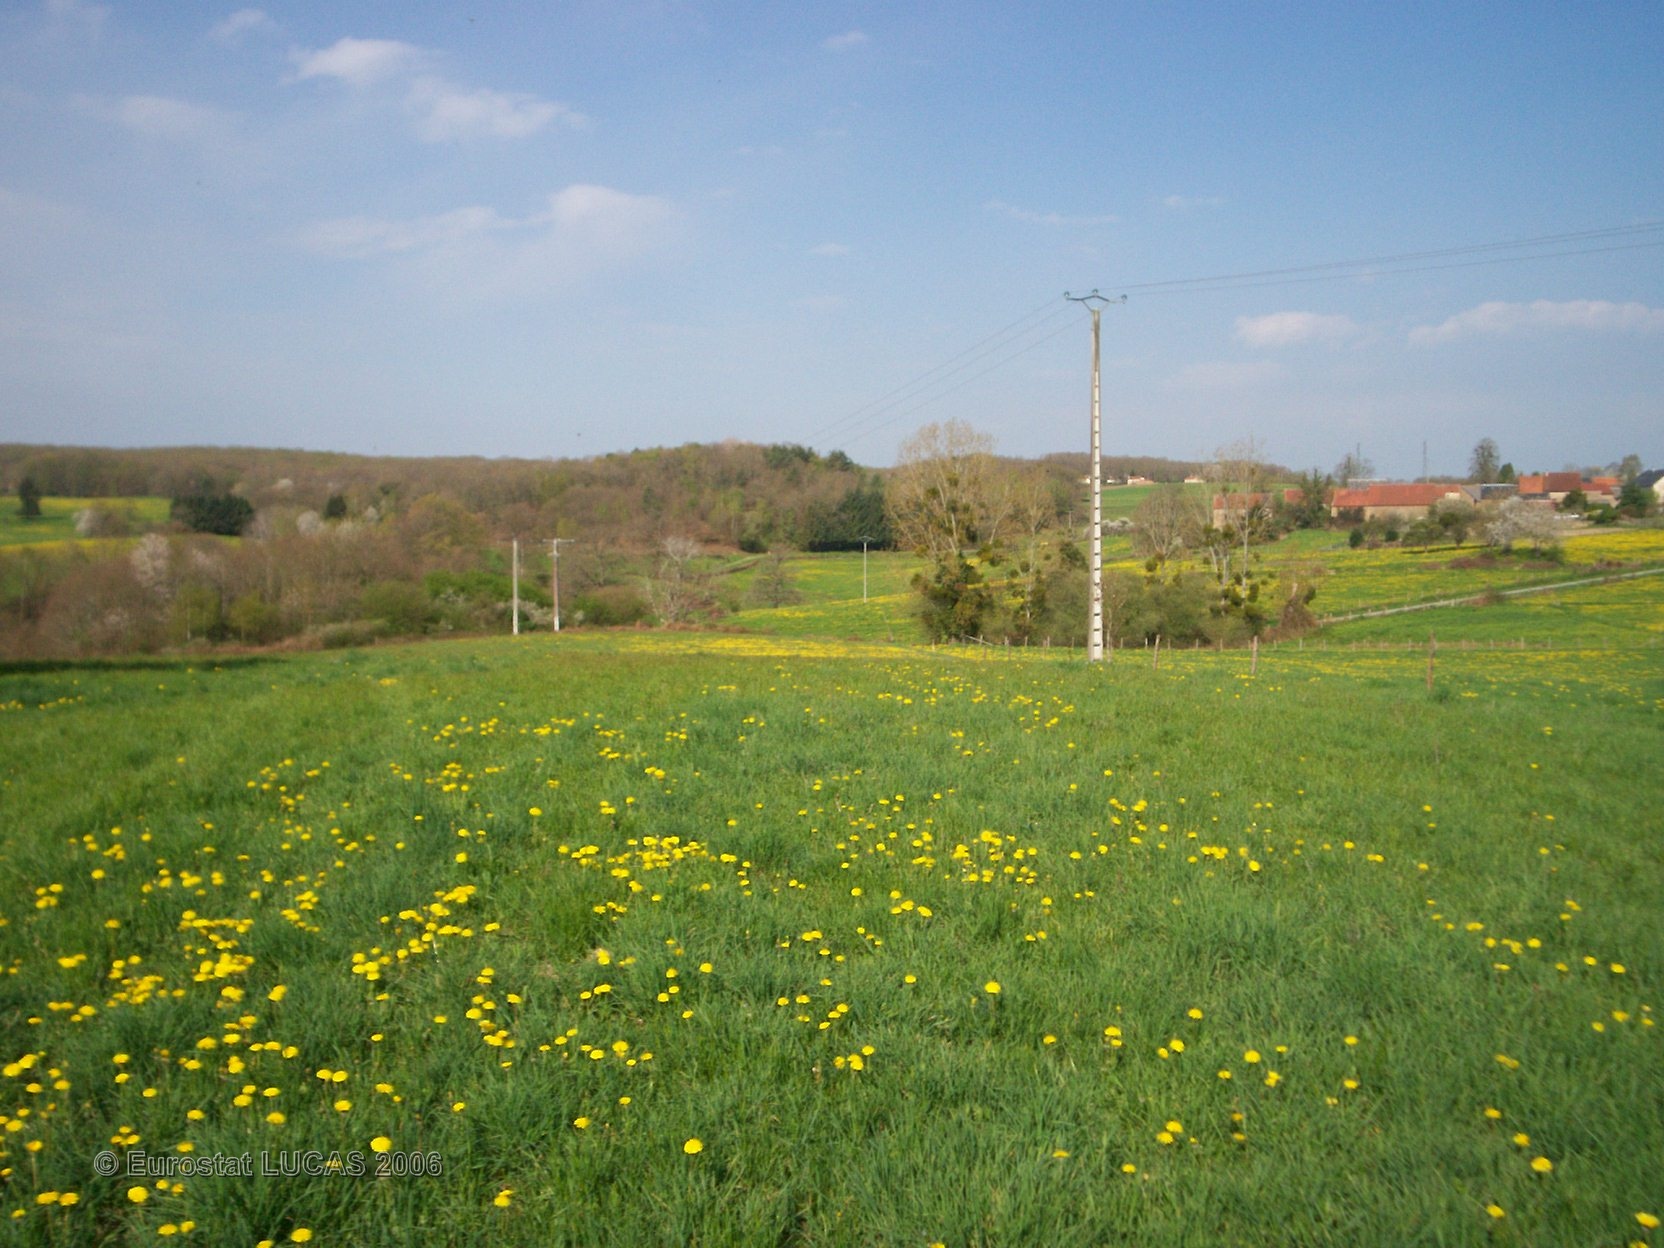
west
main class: Grassland
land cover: Grassland with sparse tree/shrub cover
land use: Agriculture (excluding fallow land and kitchen gardens)
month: April
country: FR
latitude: 46.1559
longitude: 1.4835
